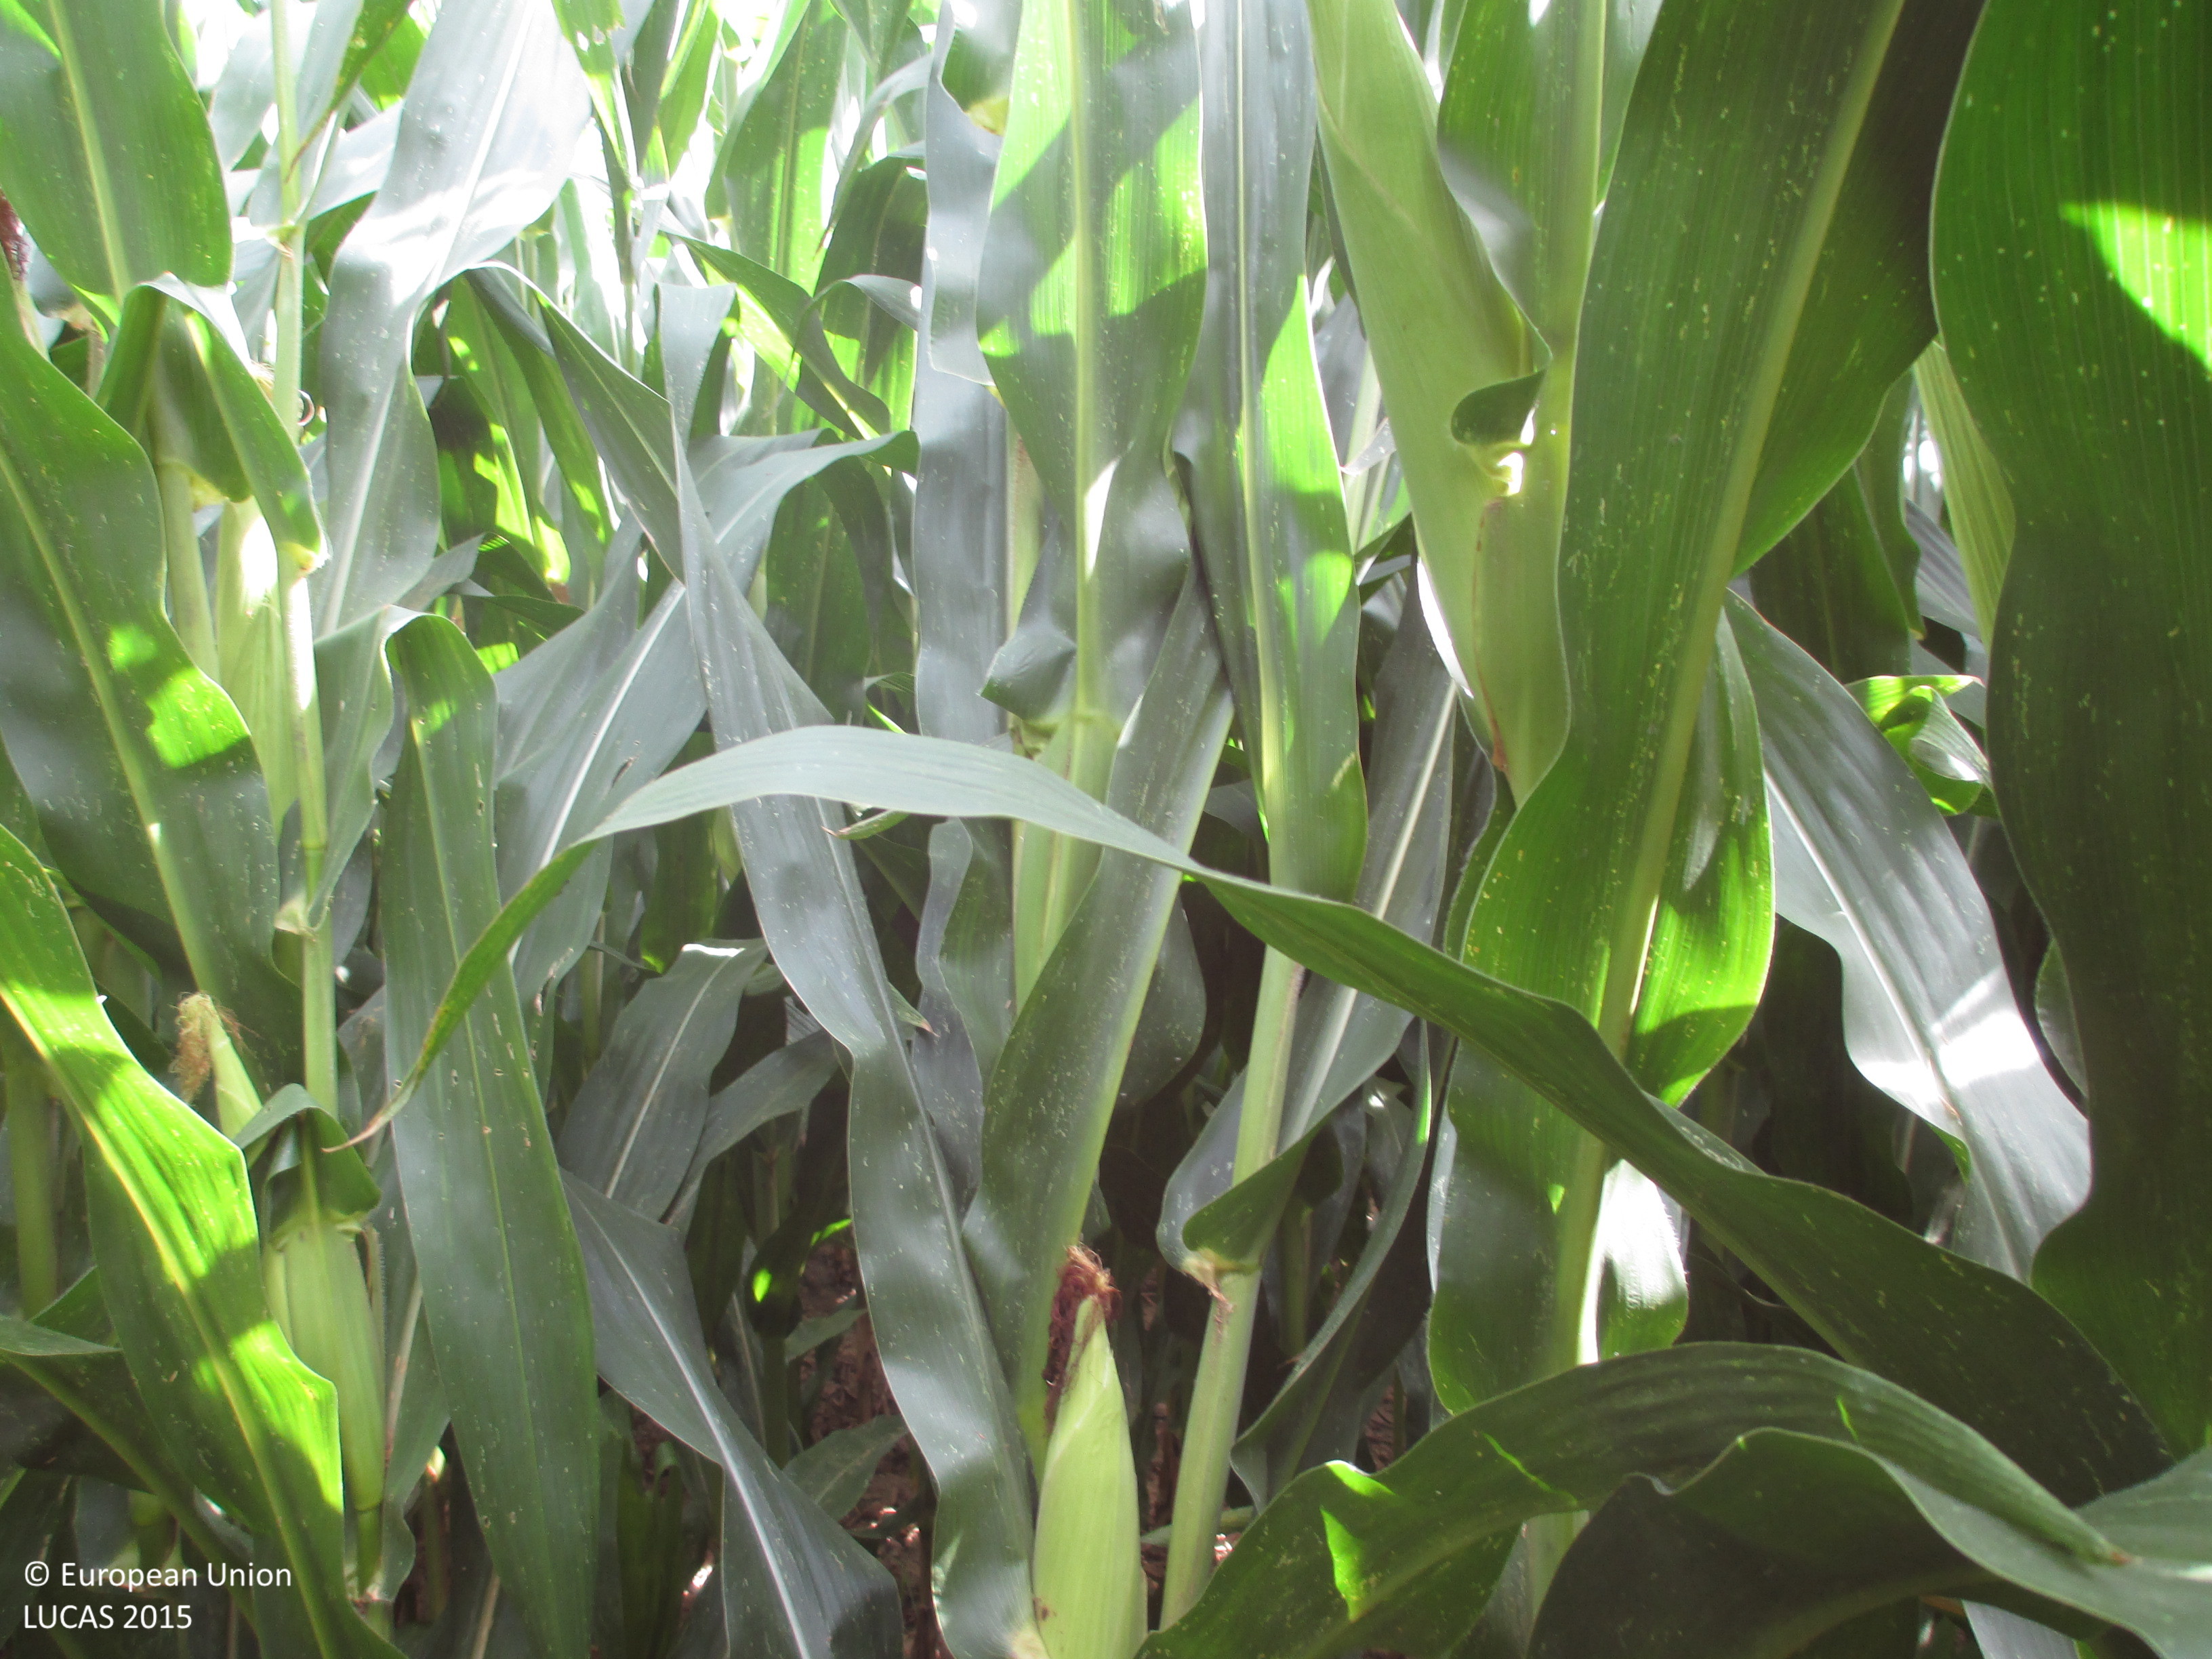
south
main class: Cropland
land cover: Maize
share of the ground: > 75 %
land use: Agriculture (excluding fallow land and kitchen gardens)
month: July
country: ES
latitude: 41.9762
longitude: 0.0010
